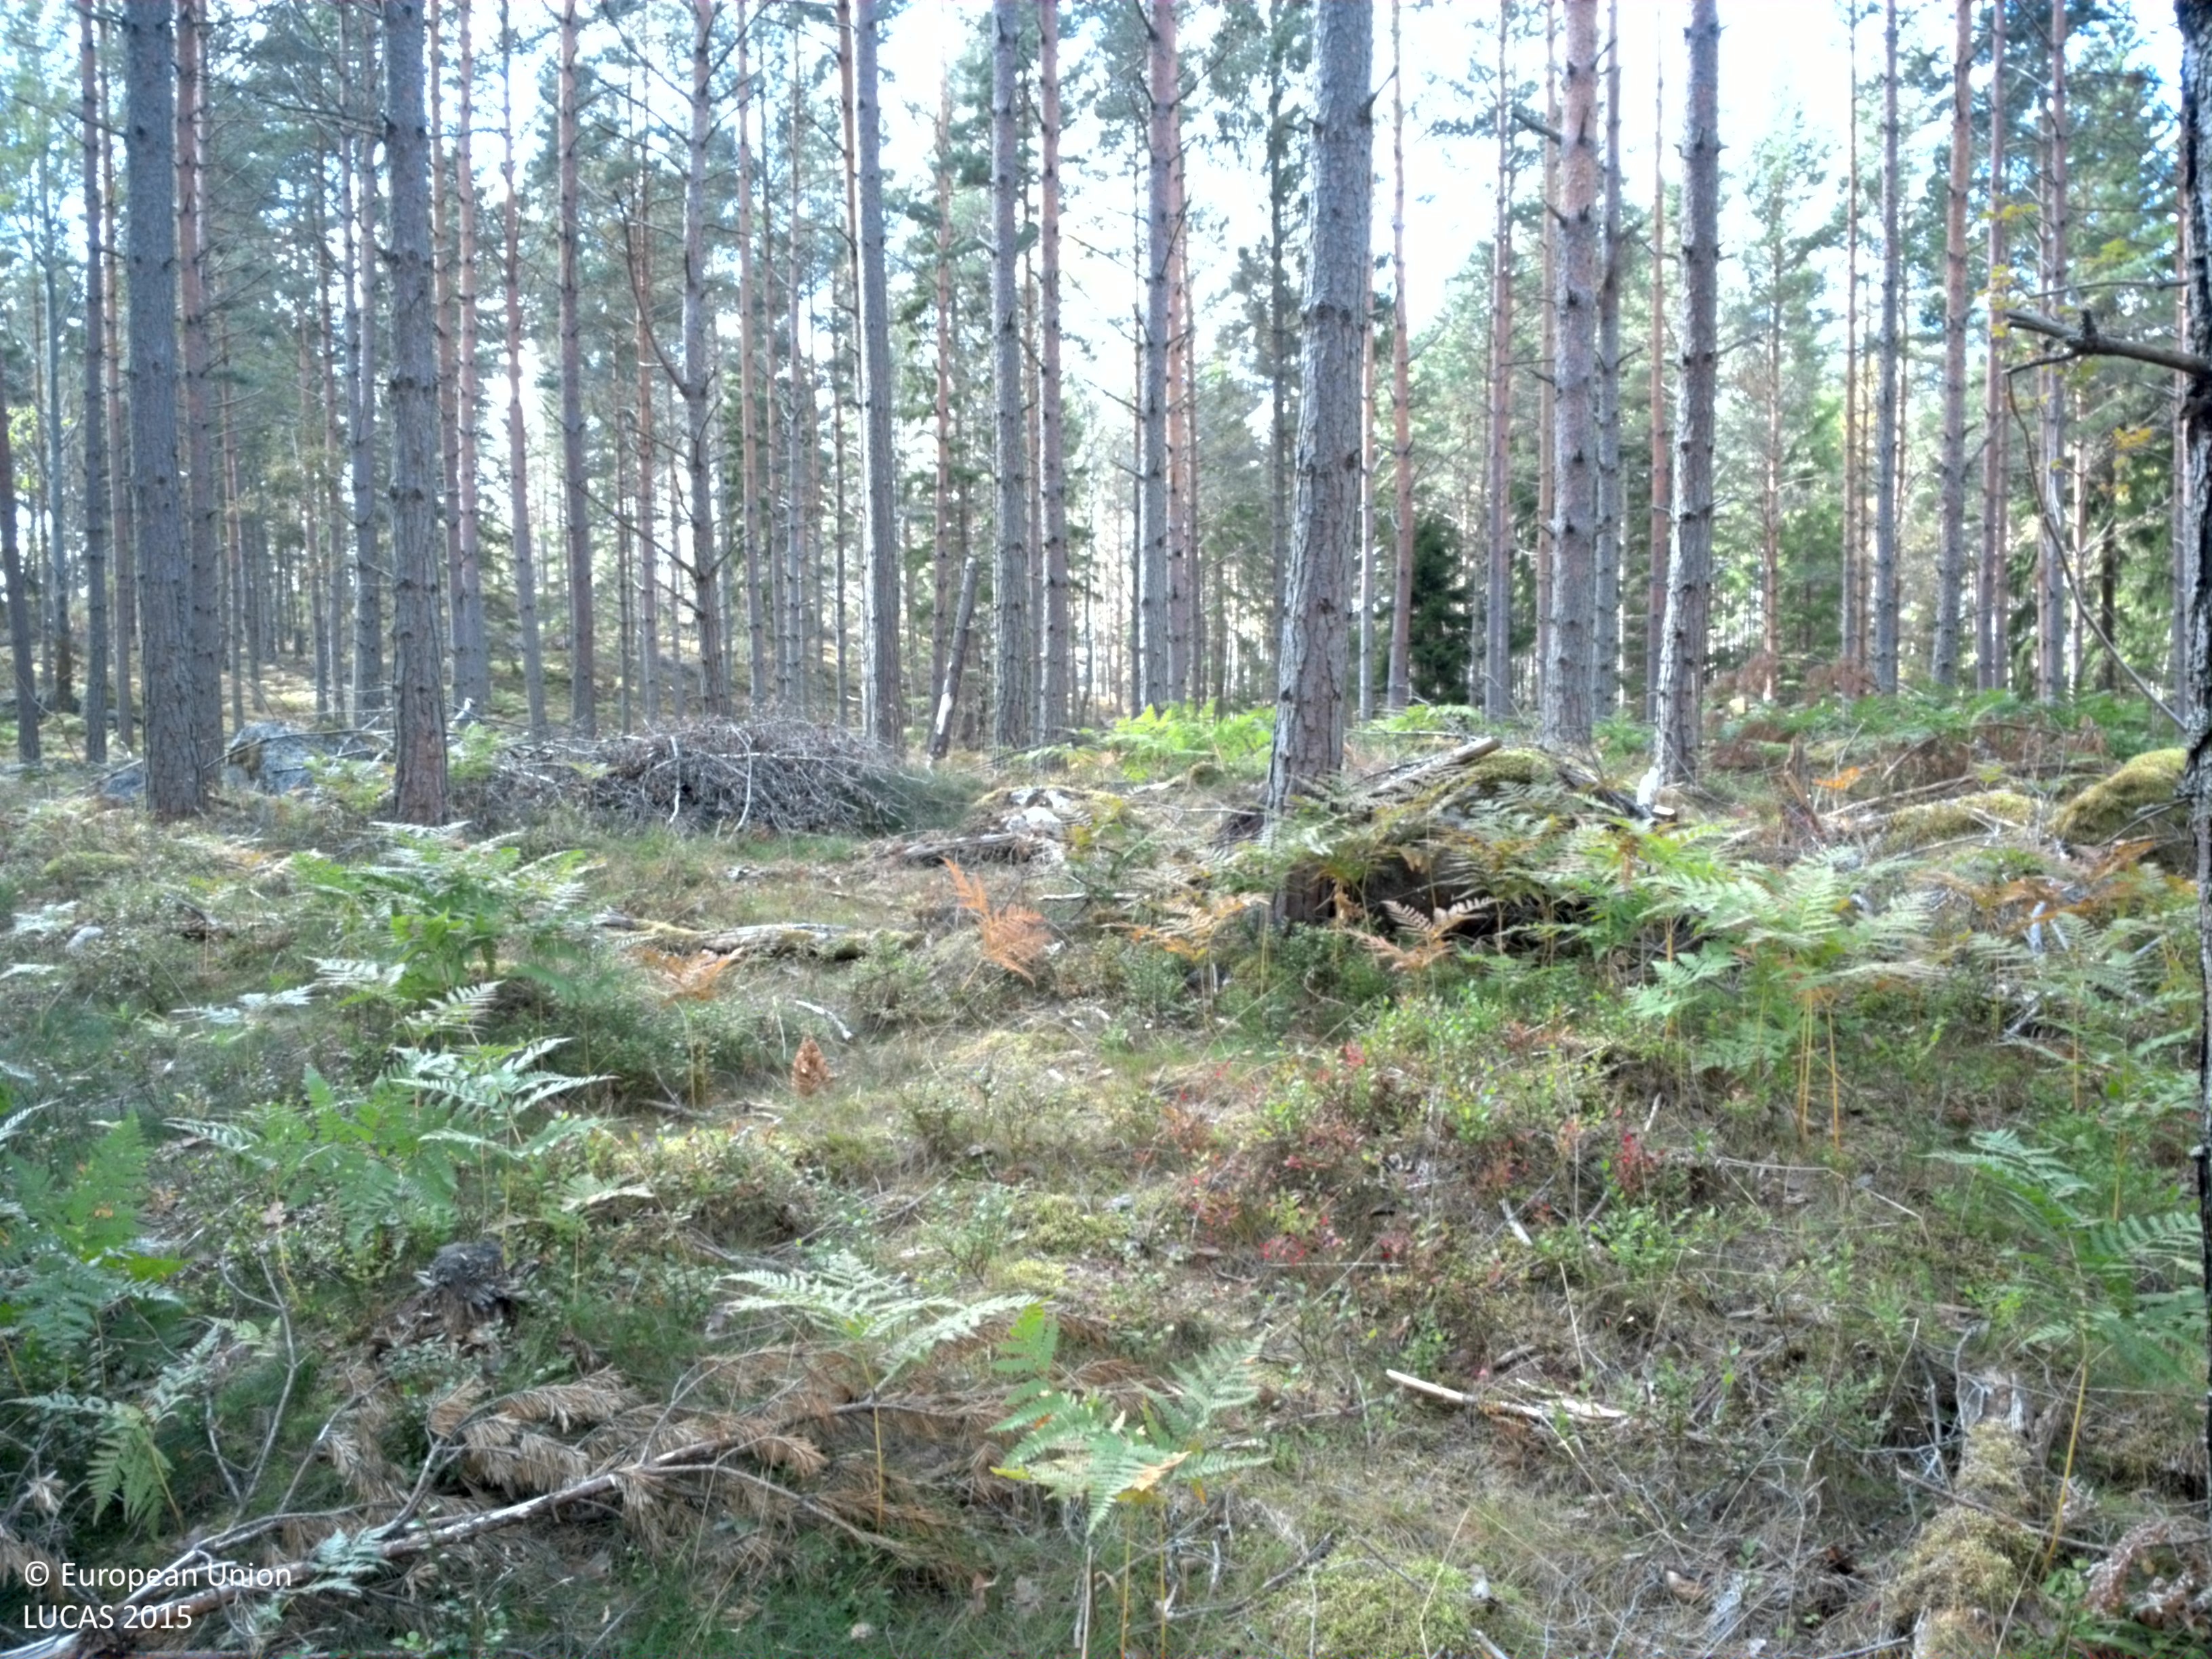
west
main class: Woodland
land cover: Pine dominated coniferous woodland
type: boreal forest
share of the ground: 50 - 75 %
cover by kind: coniferous forest trees 60 %, herbaceous plants 20 %, lichens and mosses 20 %
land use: Forestry
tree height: > 5 m
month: September
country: SE
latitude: 59.3625
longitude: 18.4981
